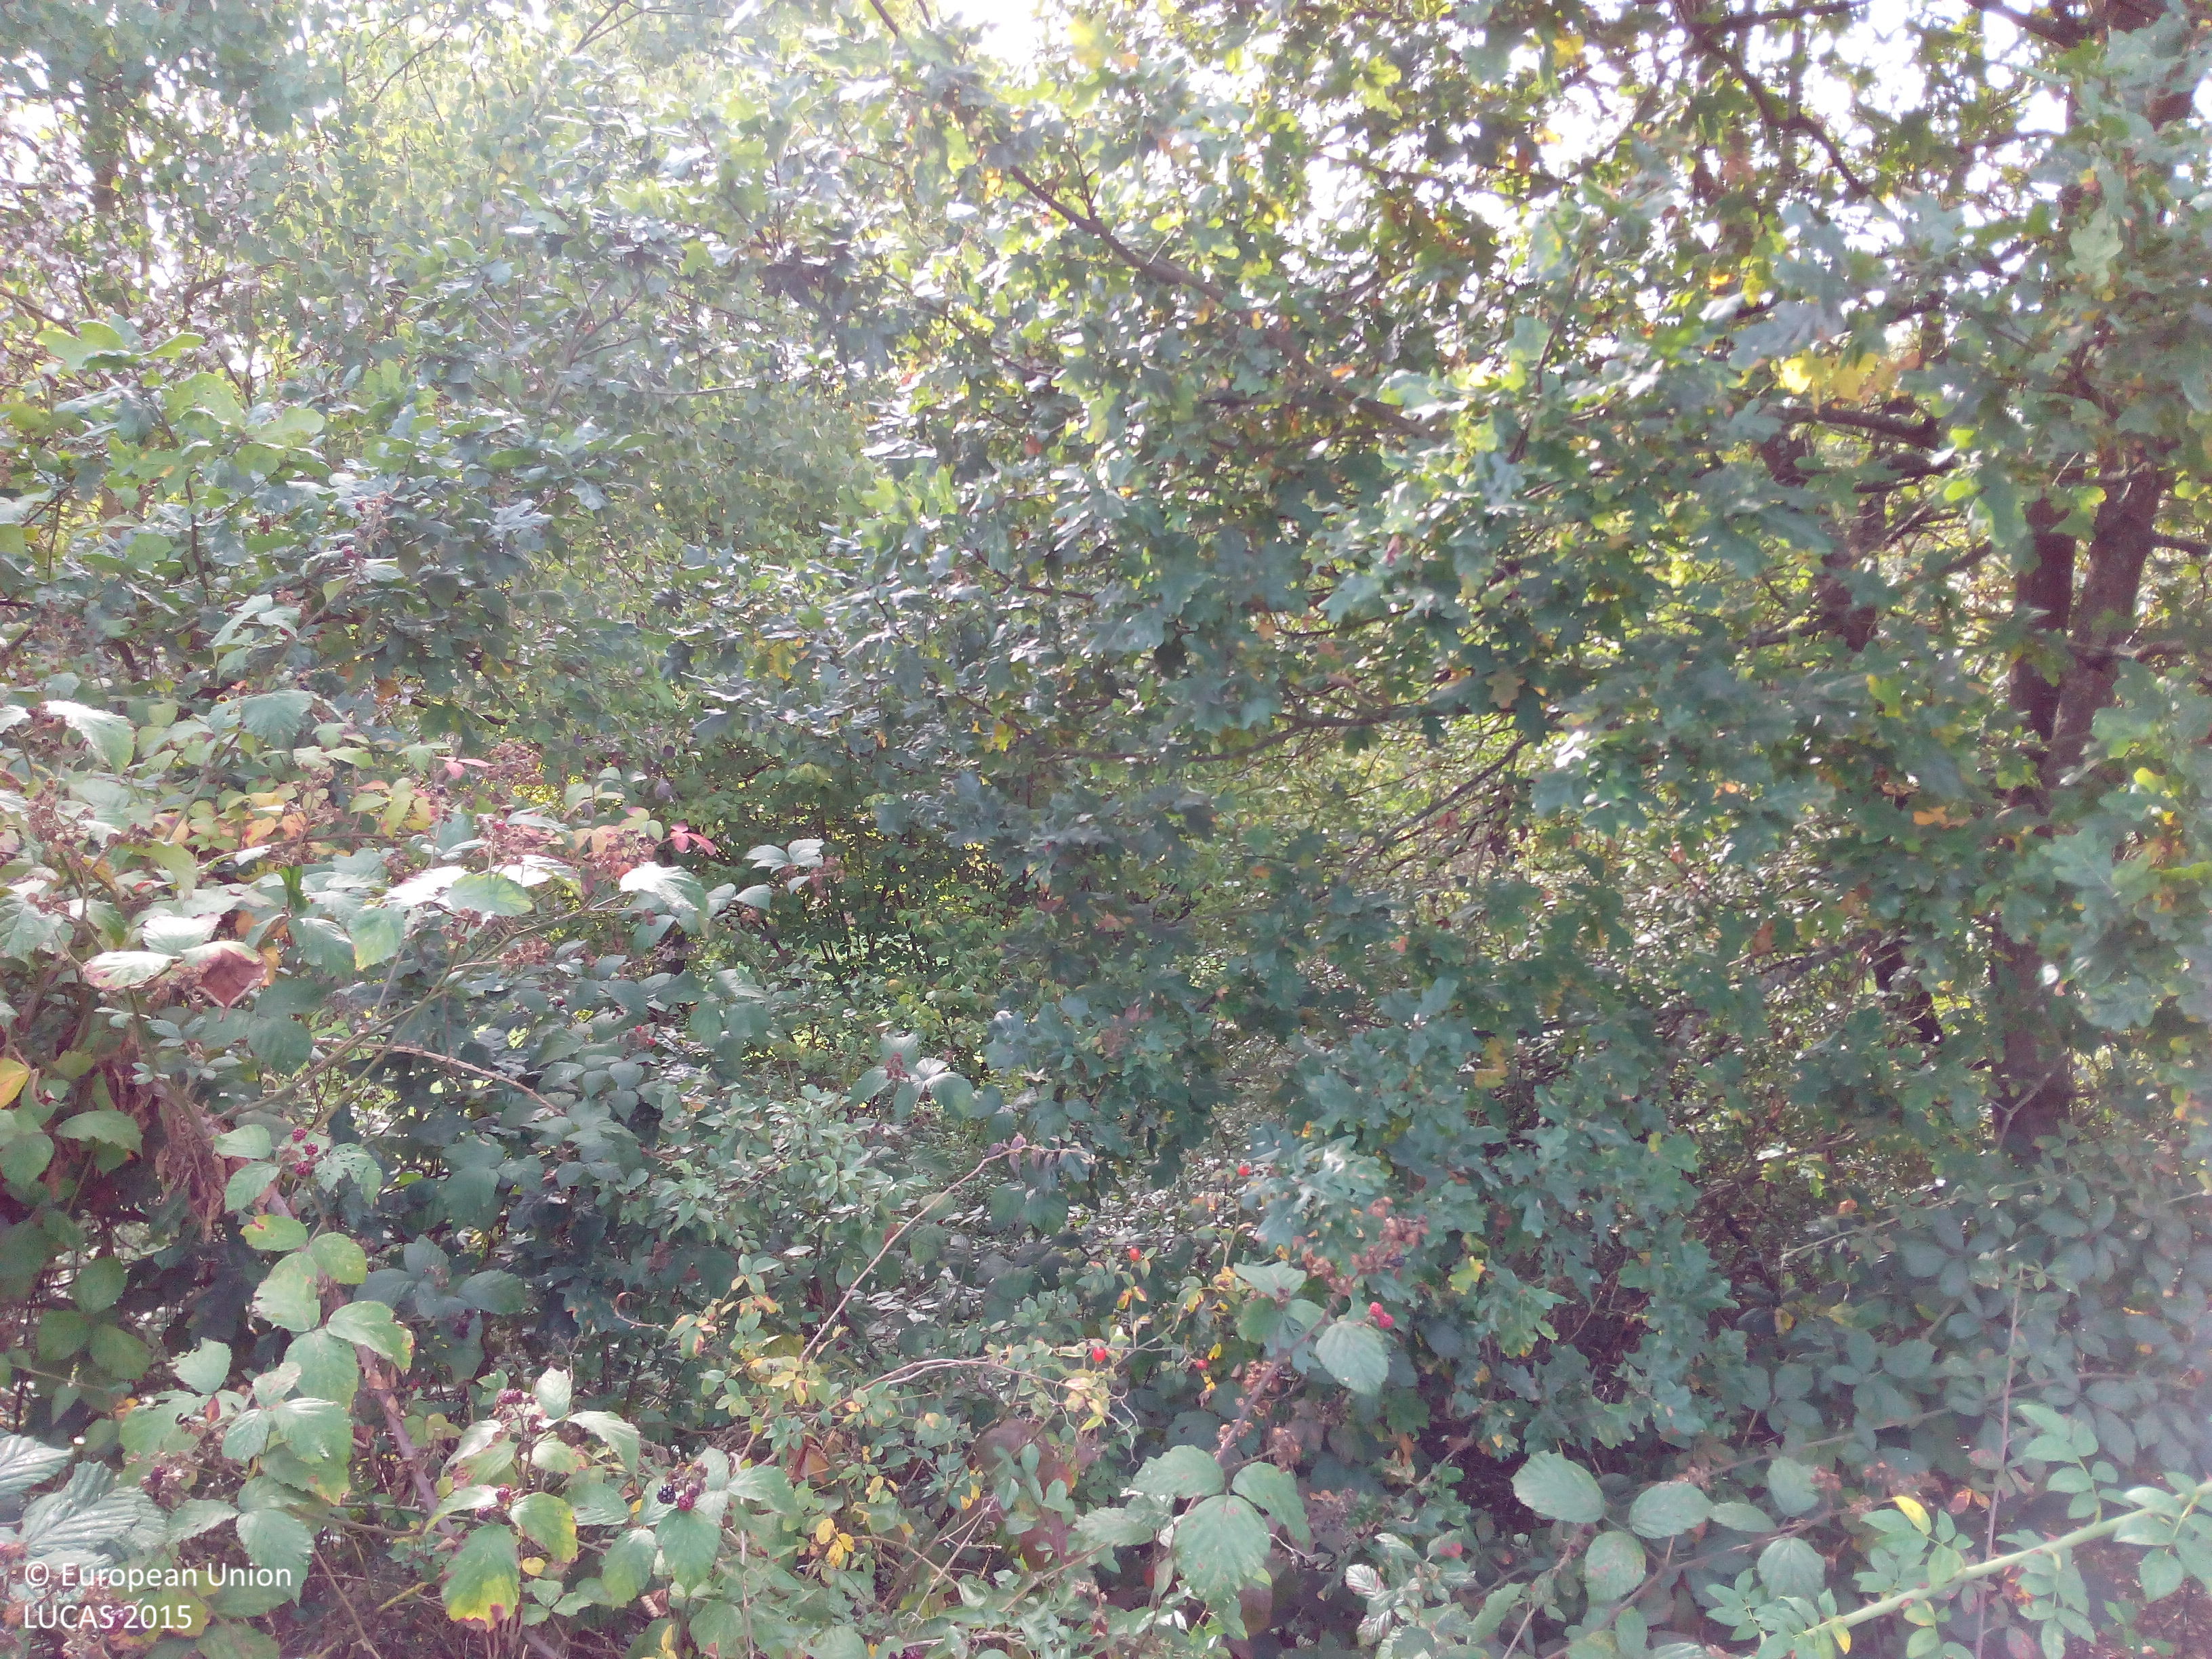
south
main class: Woodland
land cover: Broadleaved woodland
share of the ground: 50 - 75 %
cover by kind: broadleaved forest trees 70 %, shrubs 20 %, herbaceous plants 10 %
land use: Semi-natural and natural areas not in use
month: October
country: DE
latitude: 50.1453
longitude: 9.1746
